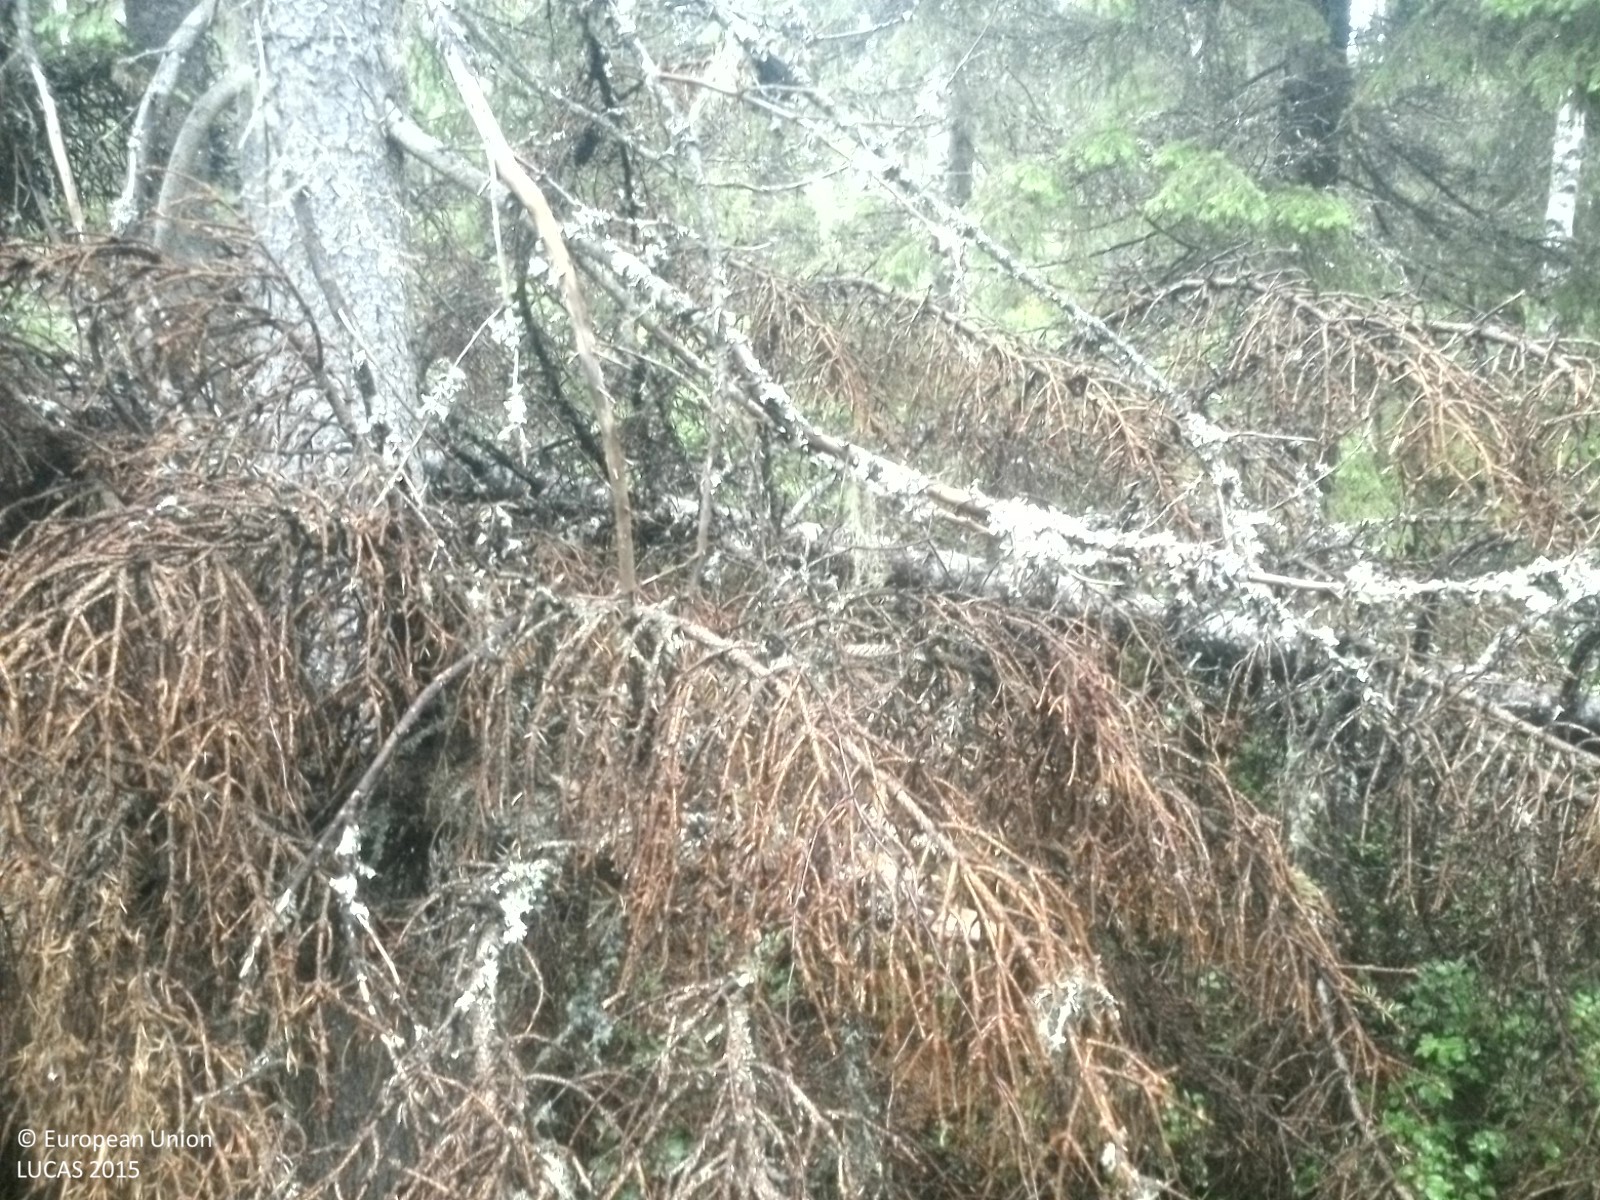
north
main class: Woodland
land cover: Spruce dominated mixed woodland
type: boreal forest
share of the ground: 50 - 75 %
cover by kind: coniferous forest trees 45 %, broadleaved forest trees 25 %, shrubs 15 %, lichens and mosses 15 %
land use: Forestry
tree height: > 5 m
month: July
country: SE
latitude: 62.4309
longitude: 17.0104
